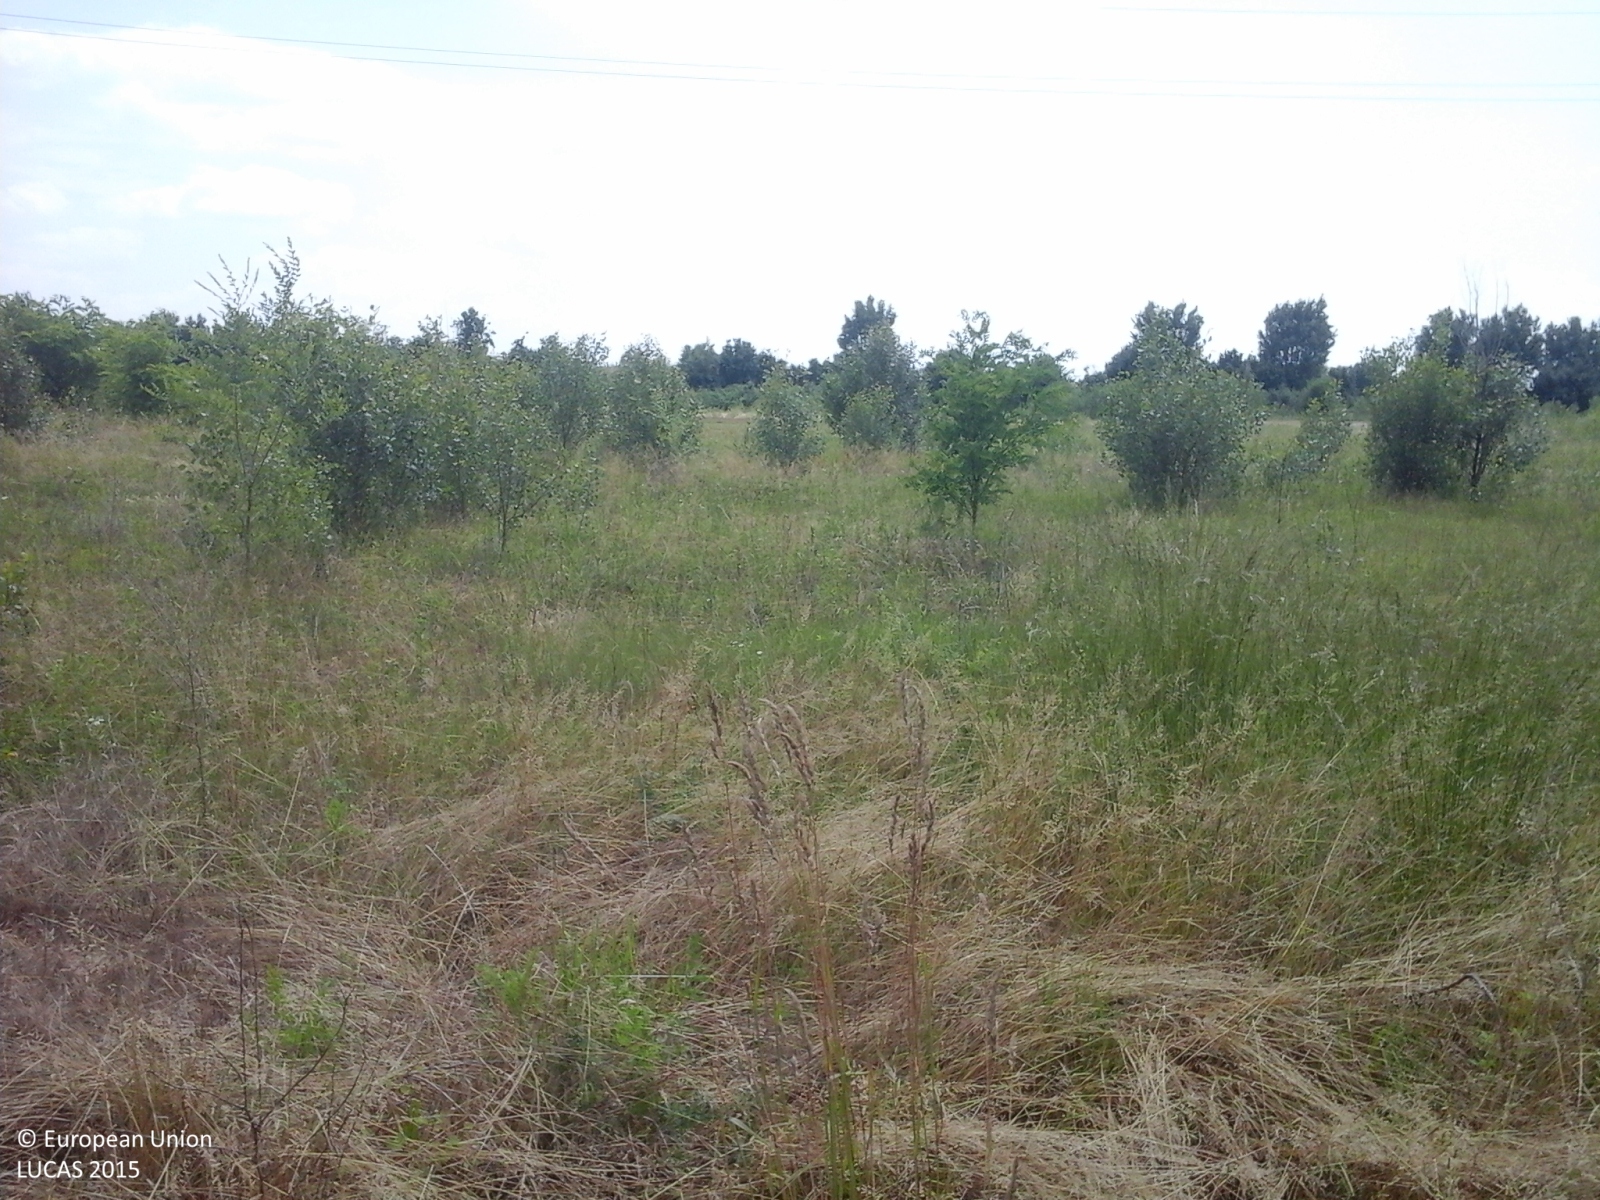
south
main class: Grassland
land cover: Grassland with sparse tree/shrub cover
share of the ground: > 75 %
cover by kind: herbaceous plants 95 %, broadleaved forest trees 5 %
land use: Abandoned areas
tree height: < 5 m
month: May
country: IT
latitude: 45.6556
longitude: 11.5247
